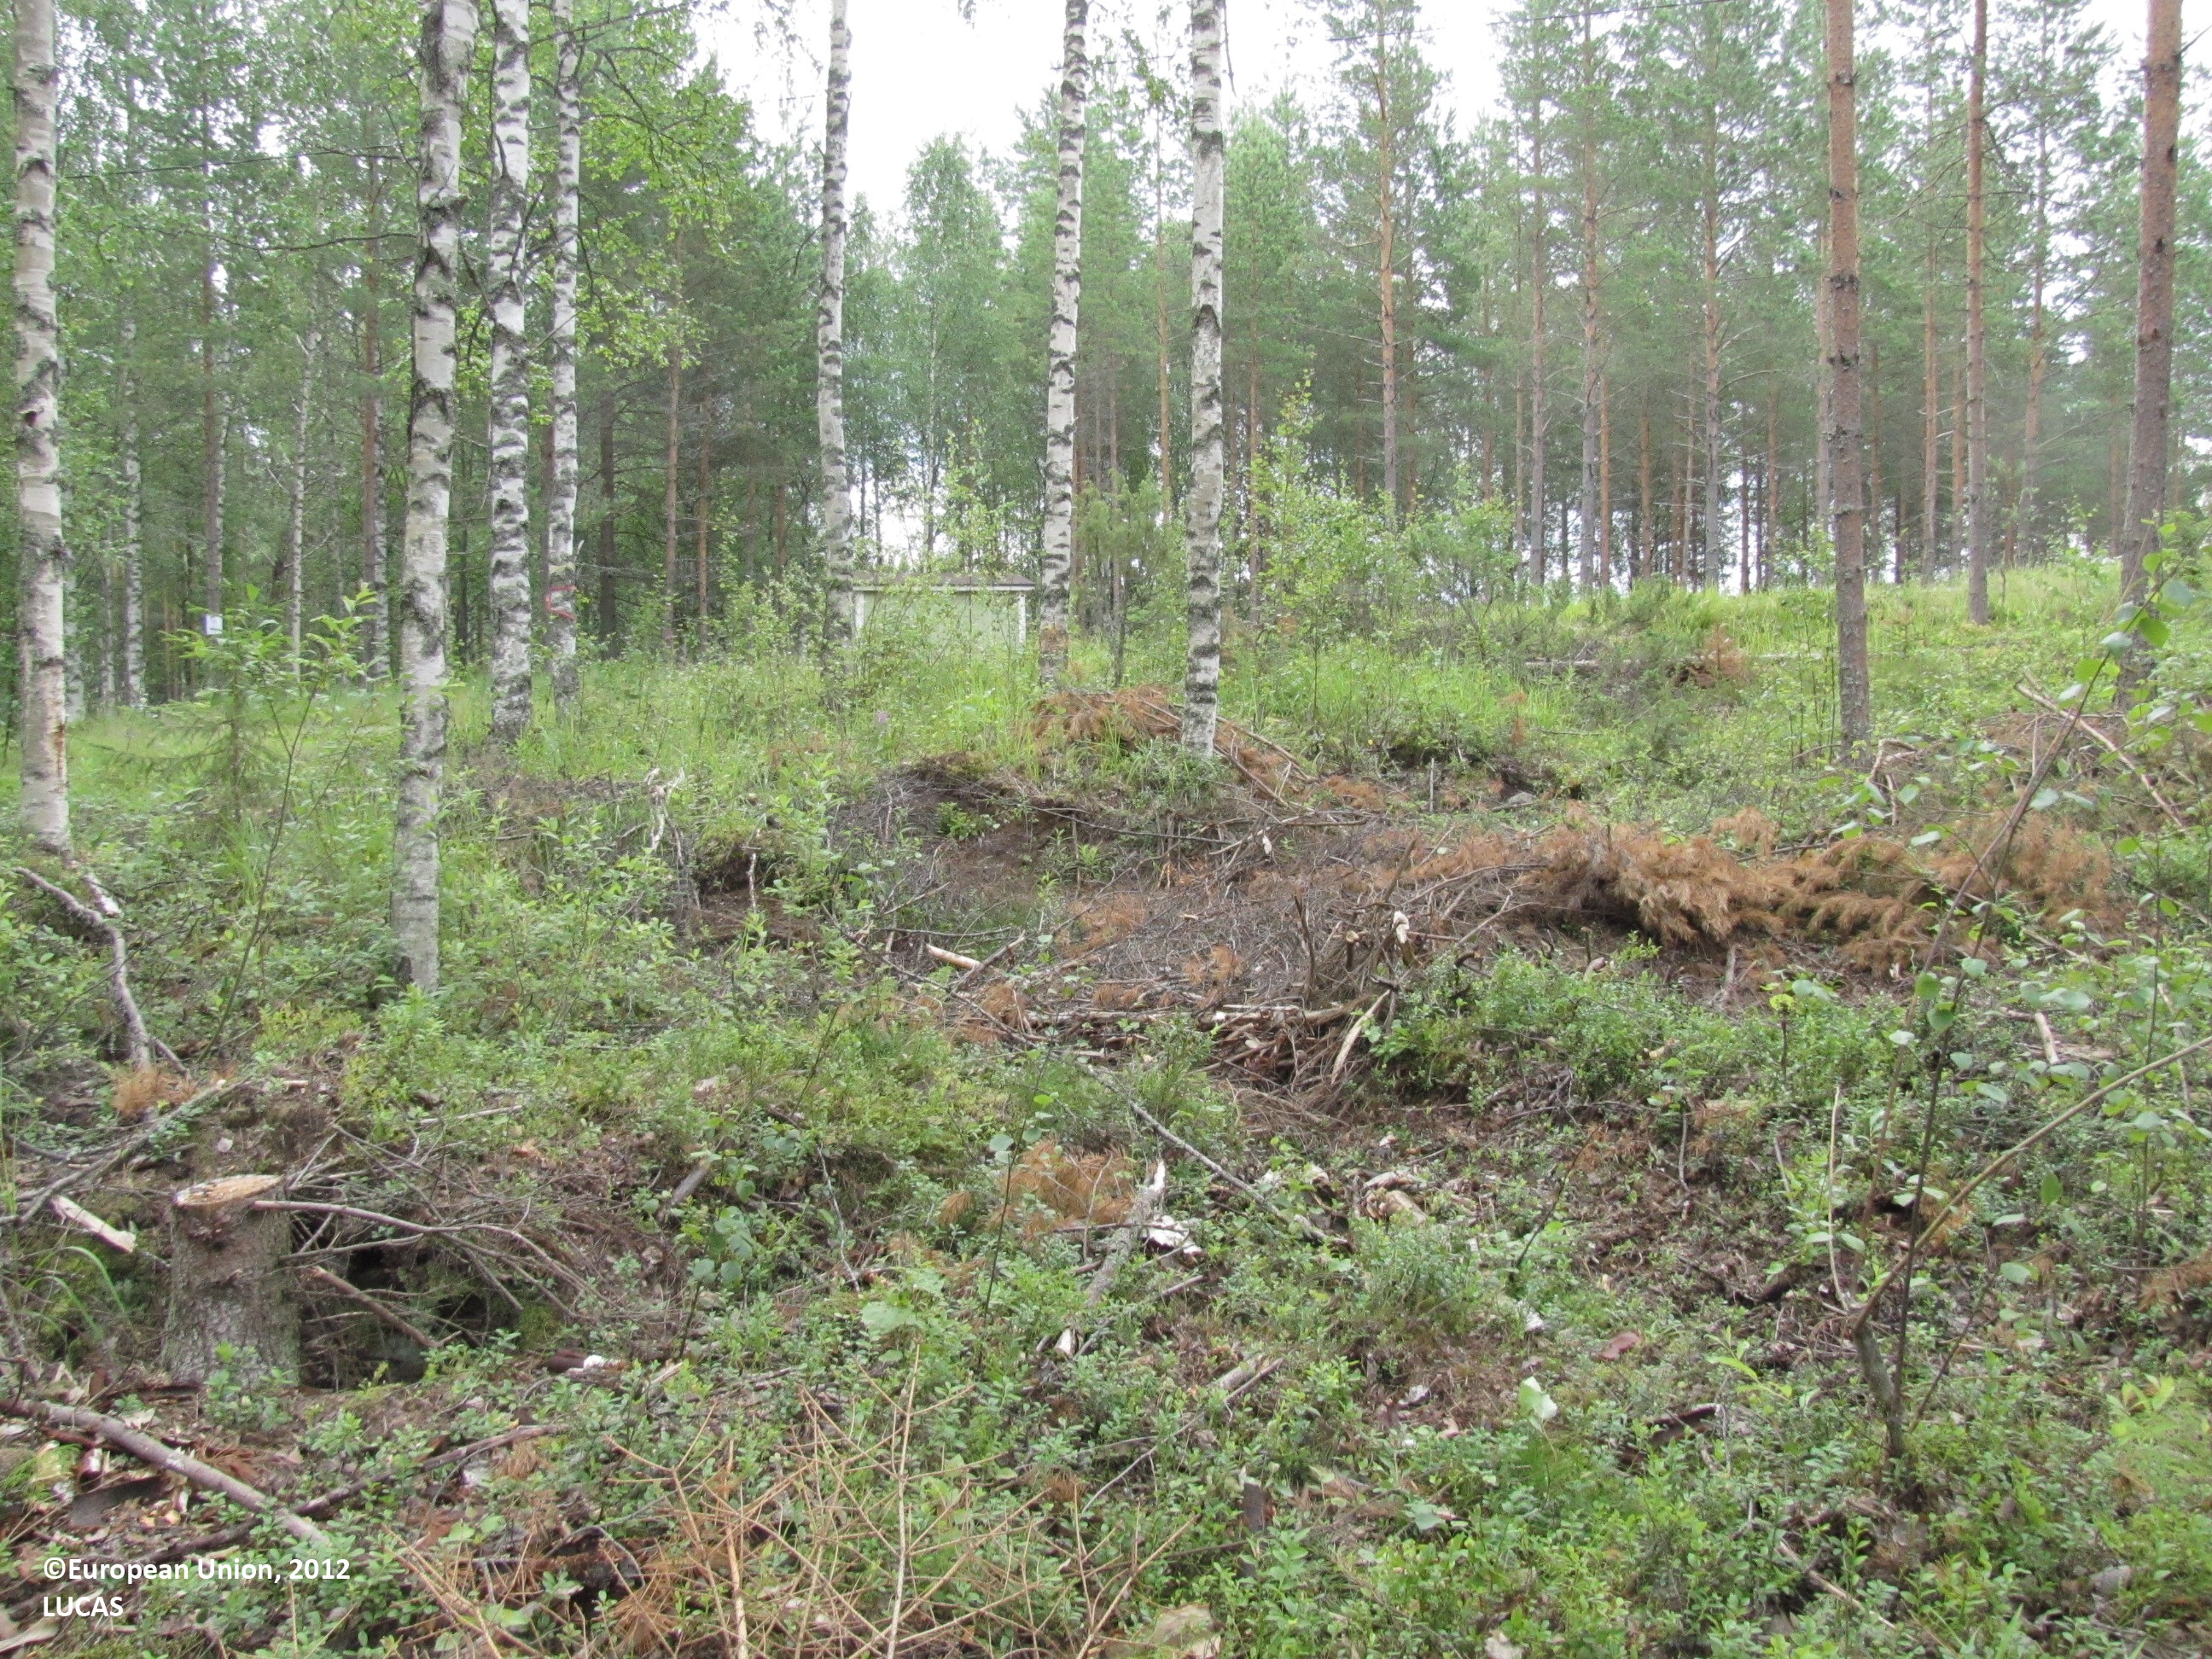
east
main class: Woodland
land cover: Pine dominated coniferous woodland
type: boreal forest
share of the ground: 50 - 75 %
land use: Forestry
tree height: > 5 m
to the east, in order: Pine dominated coniferous woodland; Broadleaved woodland; Grass margins; Tracks; Grass margins; Pine dominated coniferous woodland; Inland running water; Inland marshes; Spruce dominated coniferous woodland
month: July
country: FI
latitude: 62.6347
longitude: 23.3868
